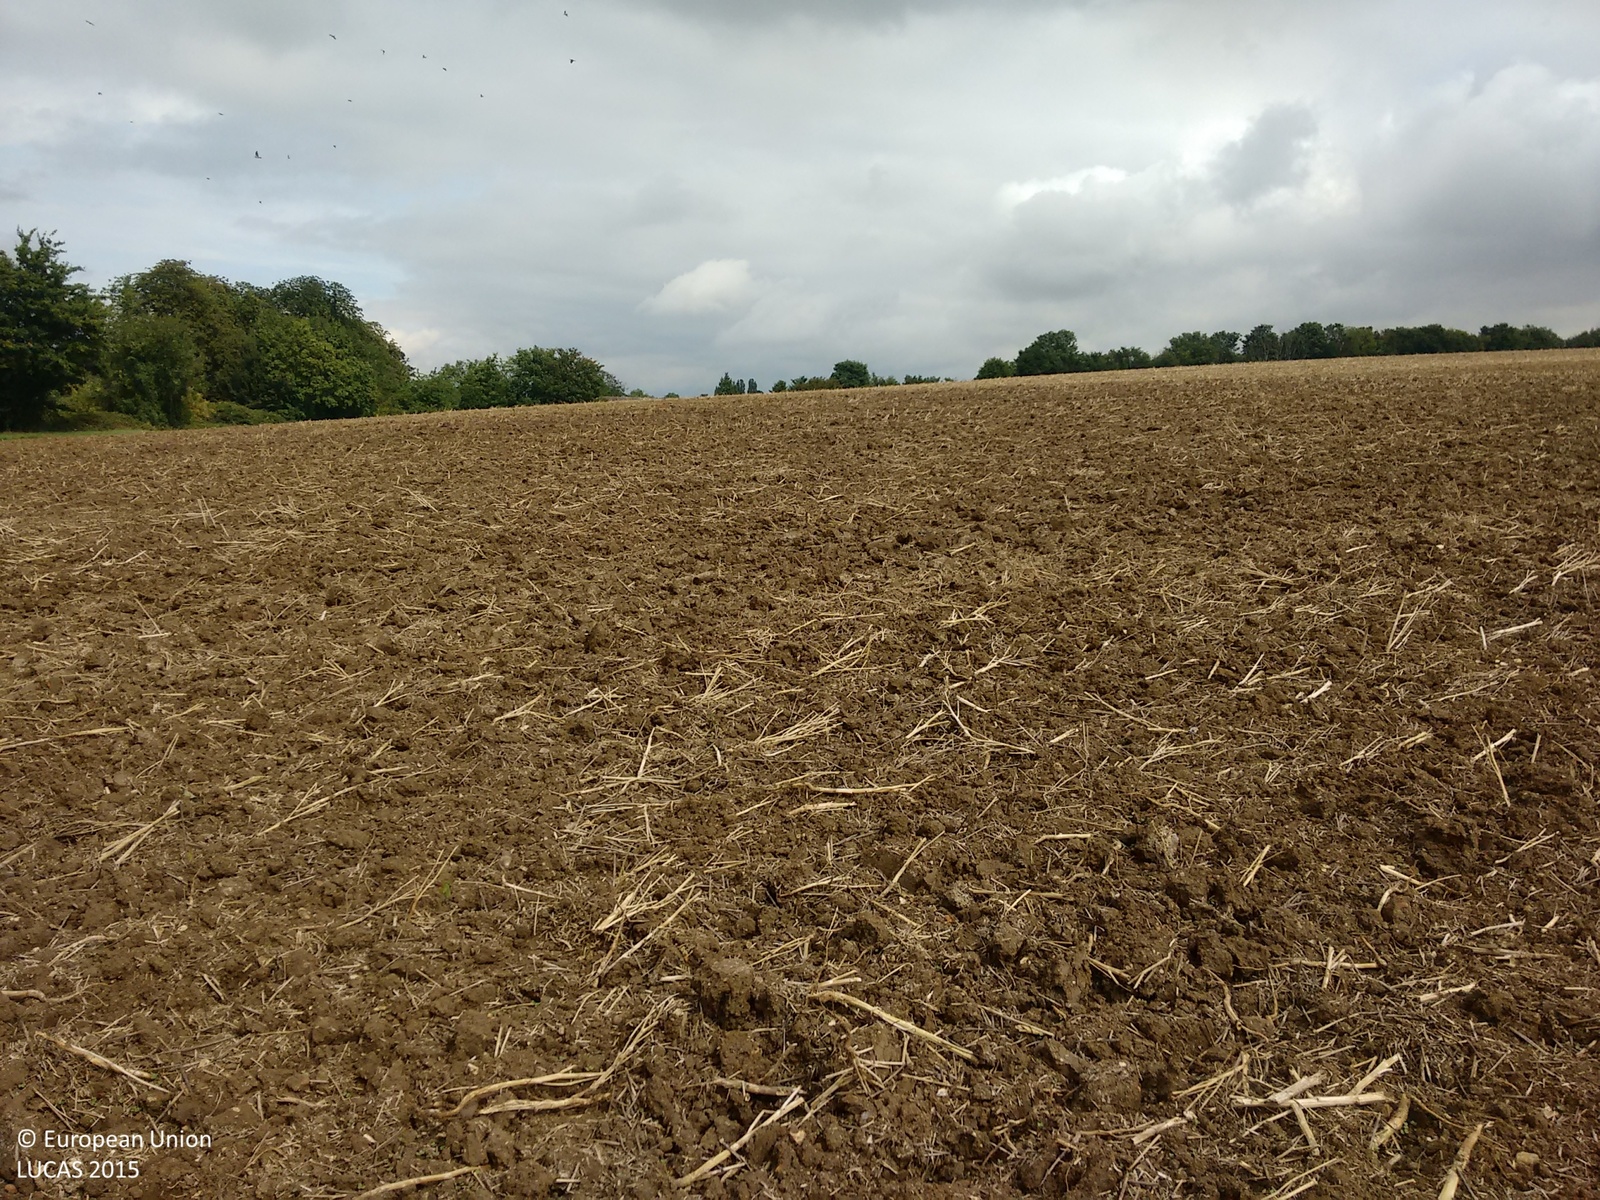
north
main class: Cropland
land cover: Rape and turnip rape
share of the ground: < 10 %
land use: Agriculture (excluding fallow land and kitchen gardens)
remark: Harvested field
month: August
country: GB
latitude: 52.1005
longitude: 0.9103
